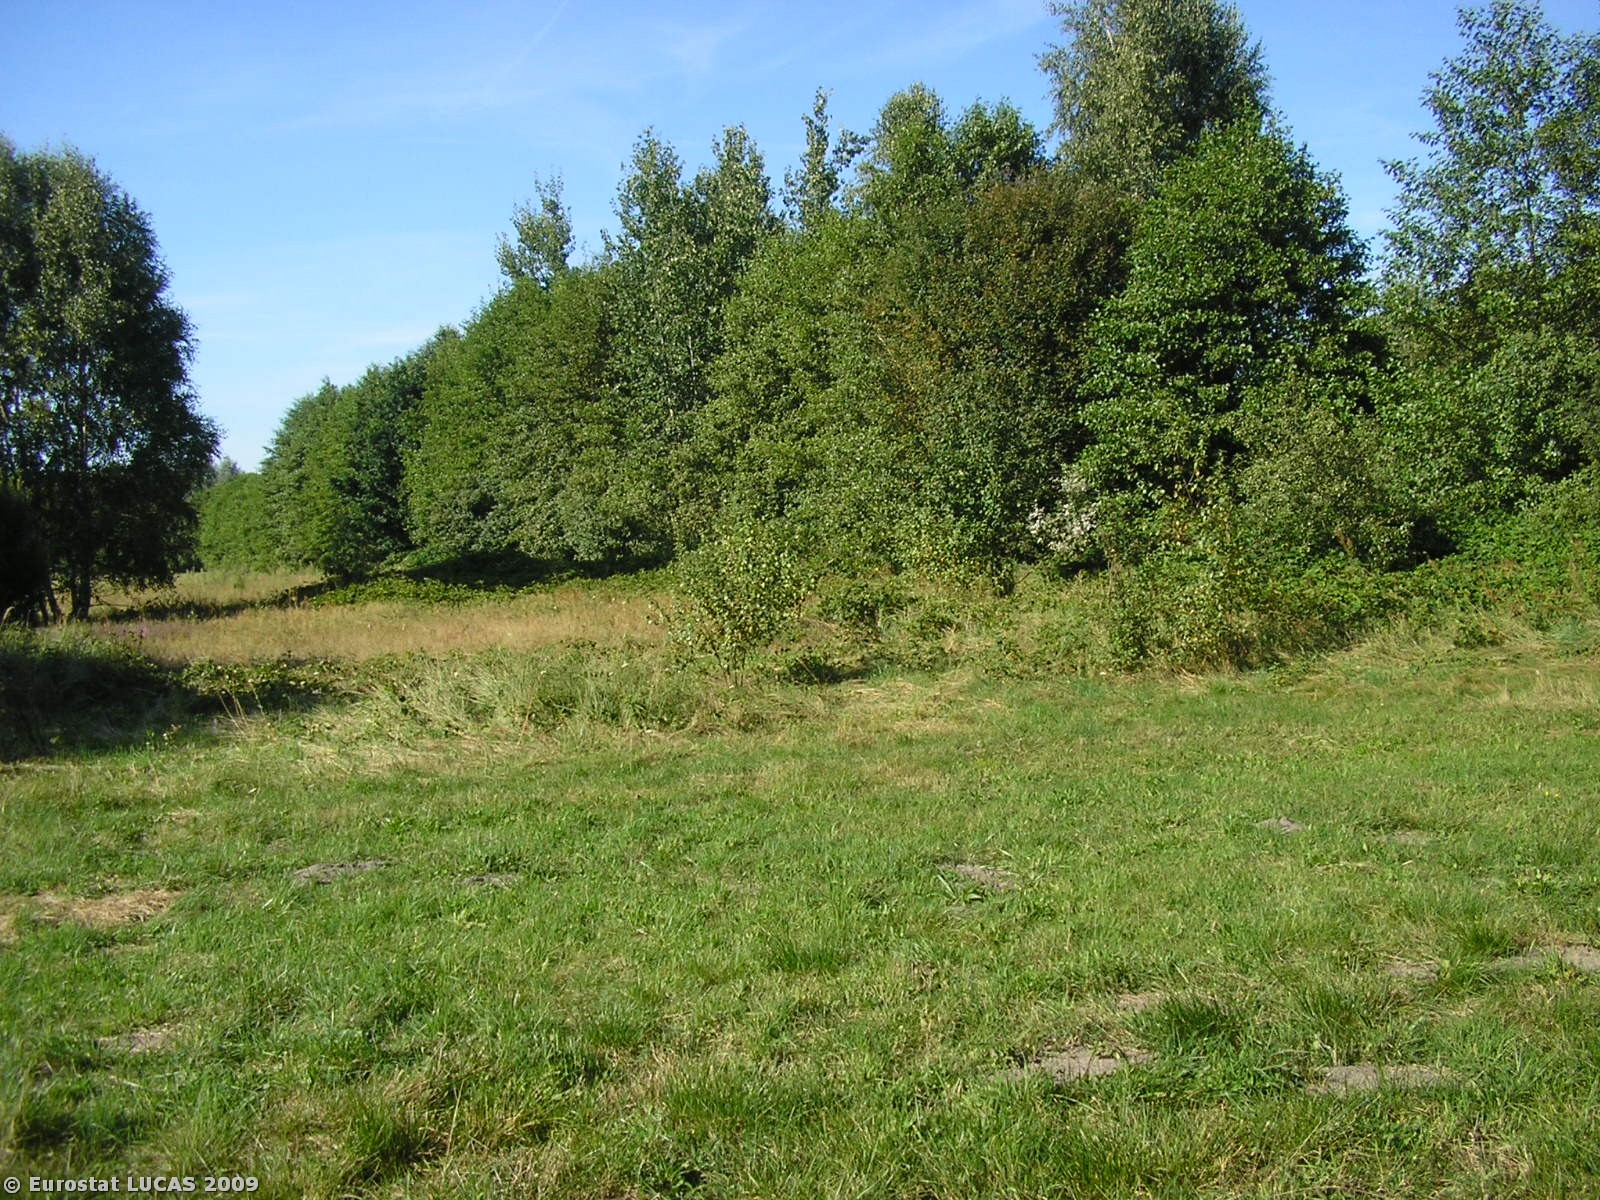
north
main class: Grassland
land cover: Grassland without tree/shrub cover
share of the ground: > 75 %
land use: Agriculture (excluding fallow land and kitchen gardens)
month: August
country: PL
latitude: 51.9973
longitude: 19.4802
